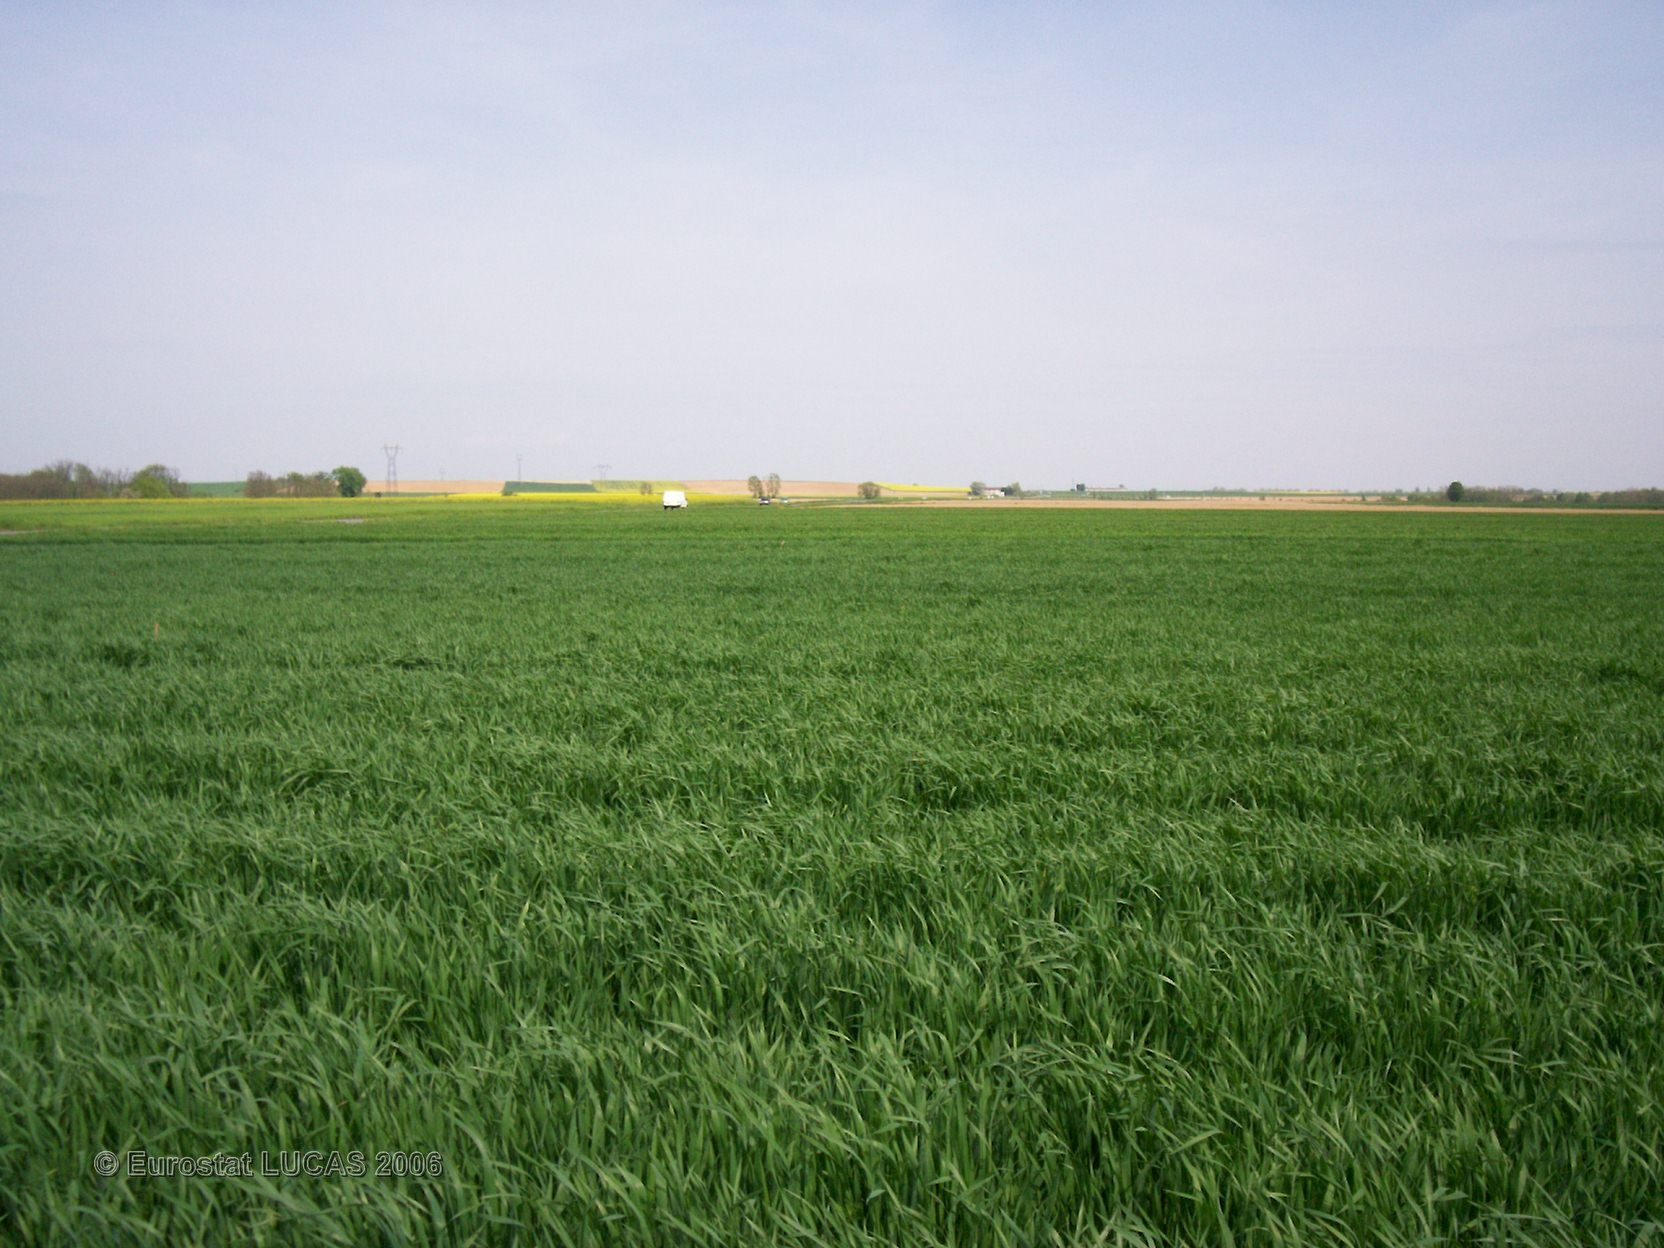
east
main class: Cropland
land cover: Oats
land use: Agriculture (excluding fallow land and kitchen gardens)
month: May
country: FR
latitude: 46.0068
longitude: 4.7727
